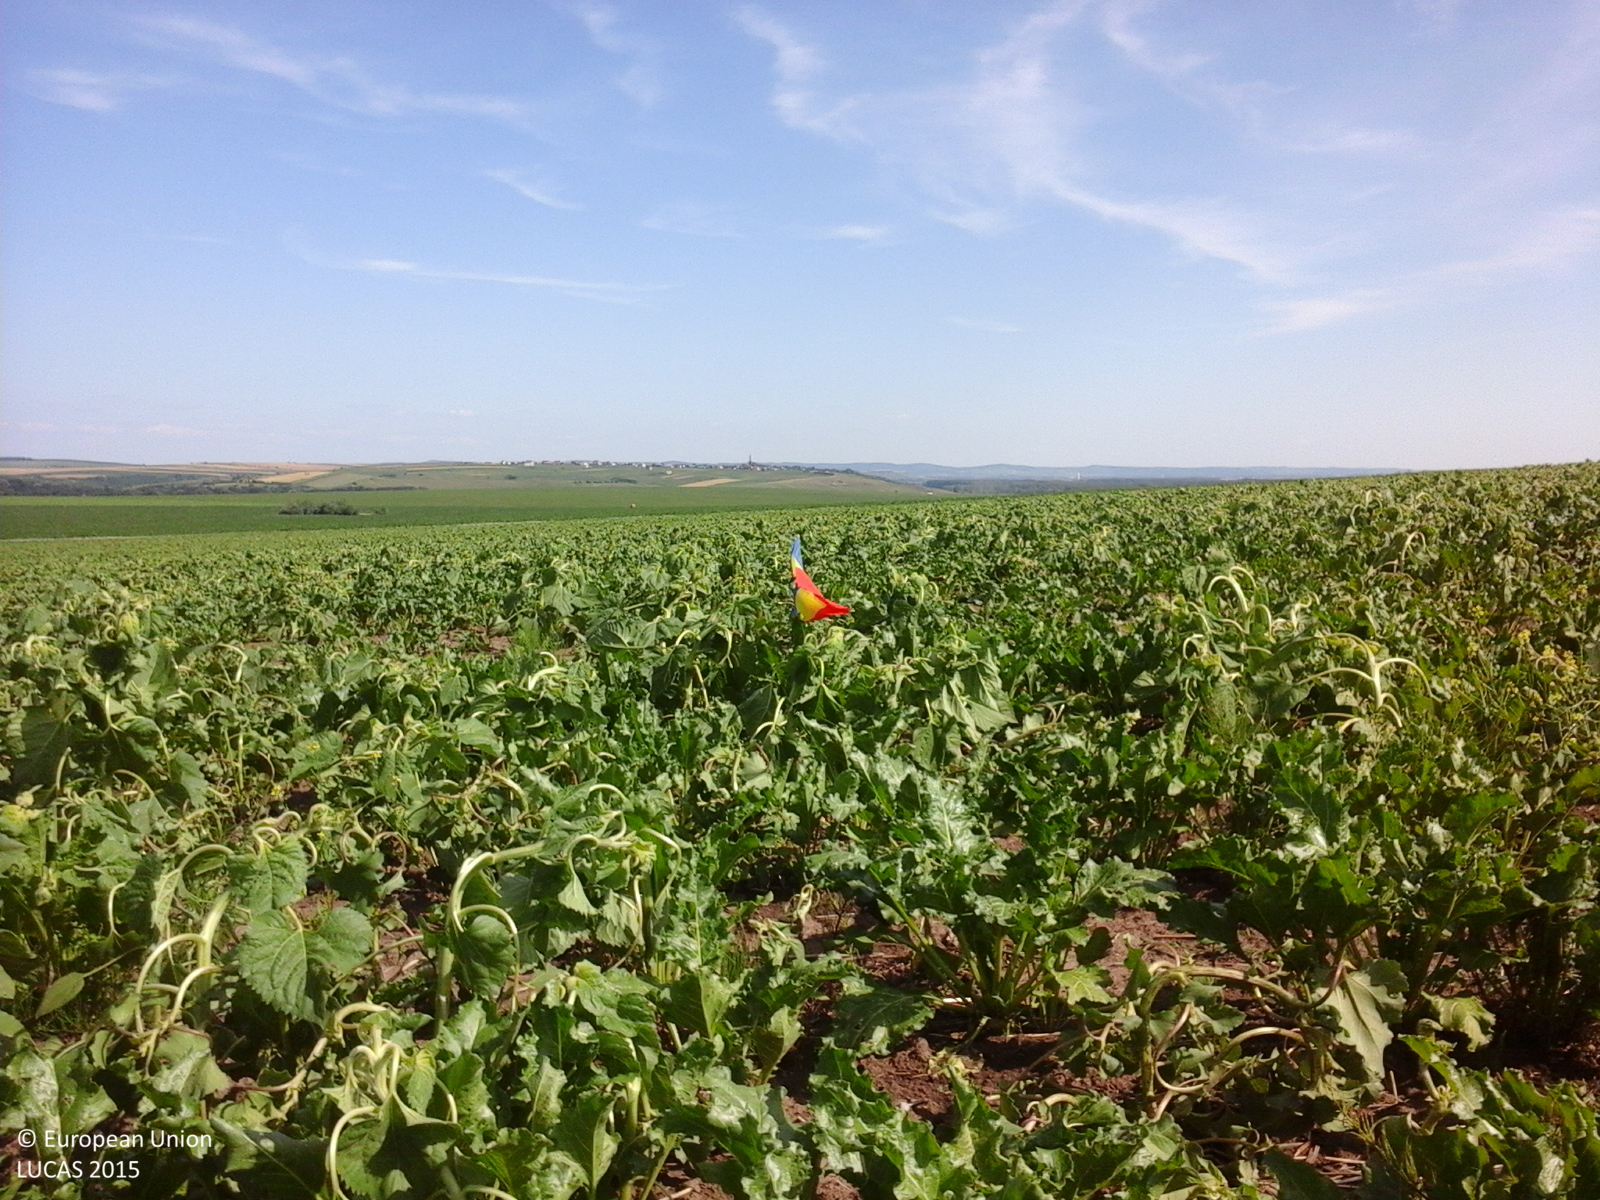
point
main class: Cropland
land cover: Sugar beet
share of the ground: > 75 %
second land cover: Sunflower
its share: 50 - 75 %
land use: Agriculture (excluding fallow land and kitchen gardens)
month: June
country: RO
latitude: 47.1084
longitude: 26.8991
